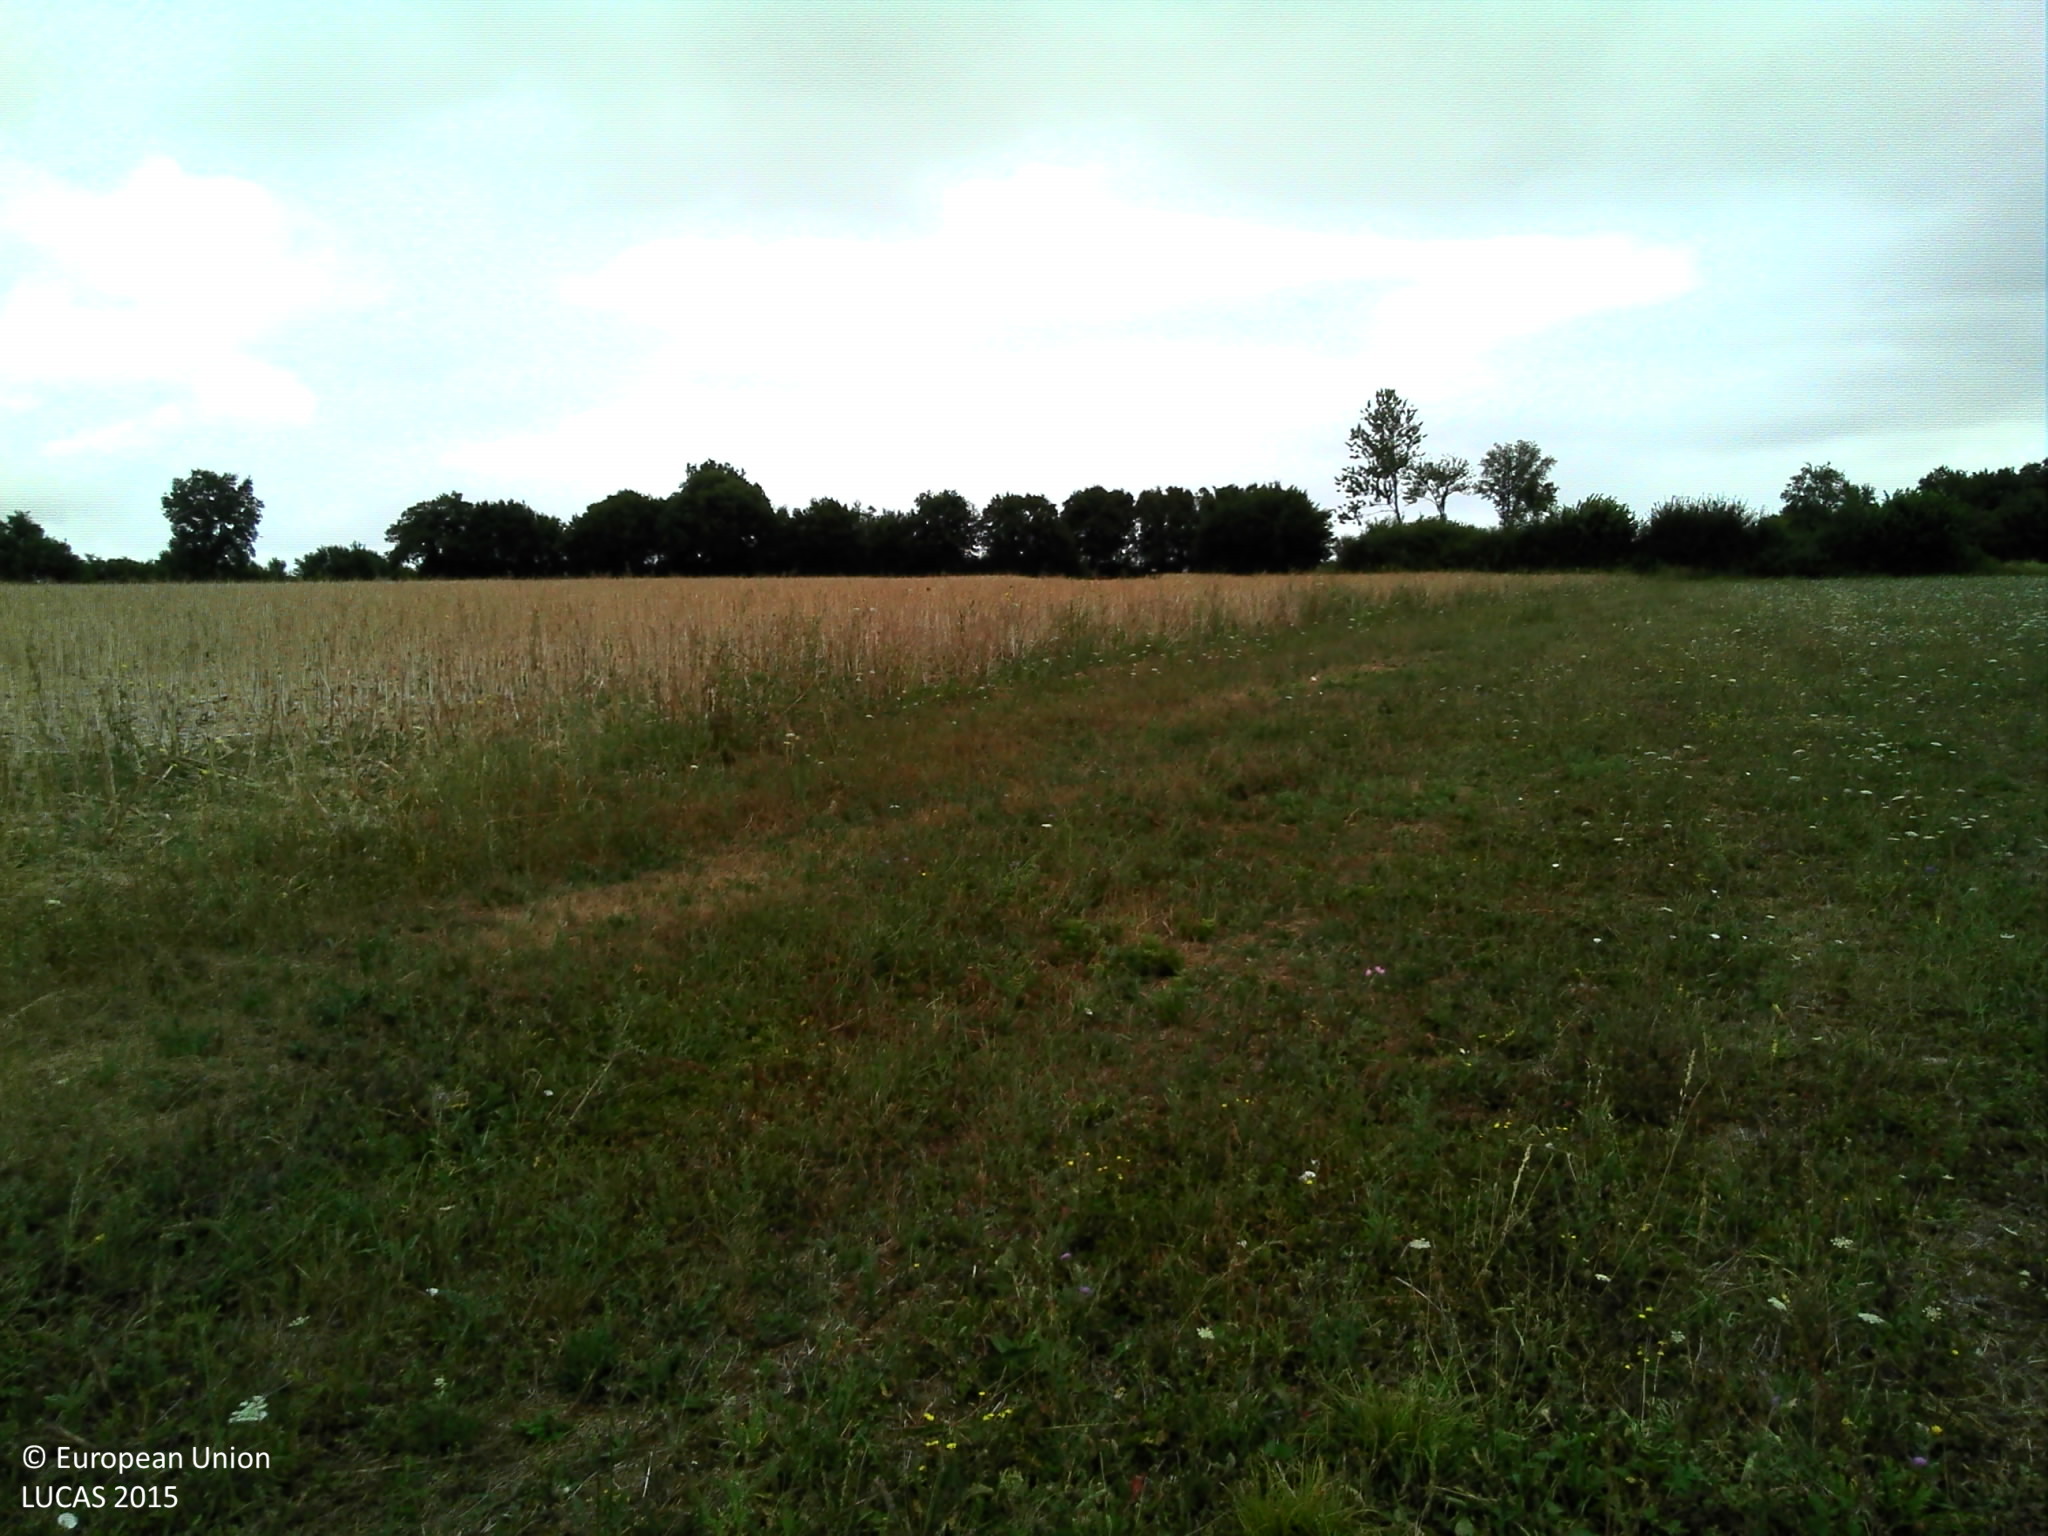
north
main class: Grassland
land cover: Grassland without tree/shrub cover
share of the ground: > 75 %
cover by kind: herbaceous plants 100 %
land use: Agriculture (excluding fallow land and kitchen gardens)
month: July
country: FR
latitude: 46.2430
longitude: 0.5816
